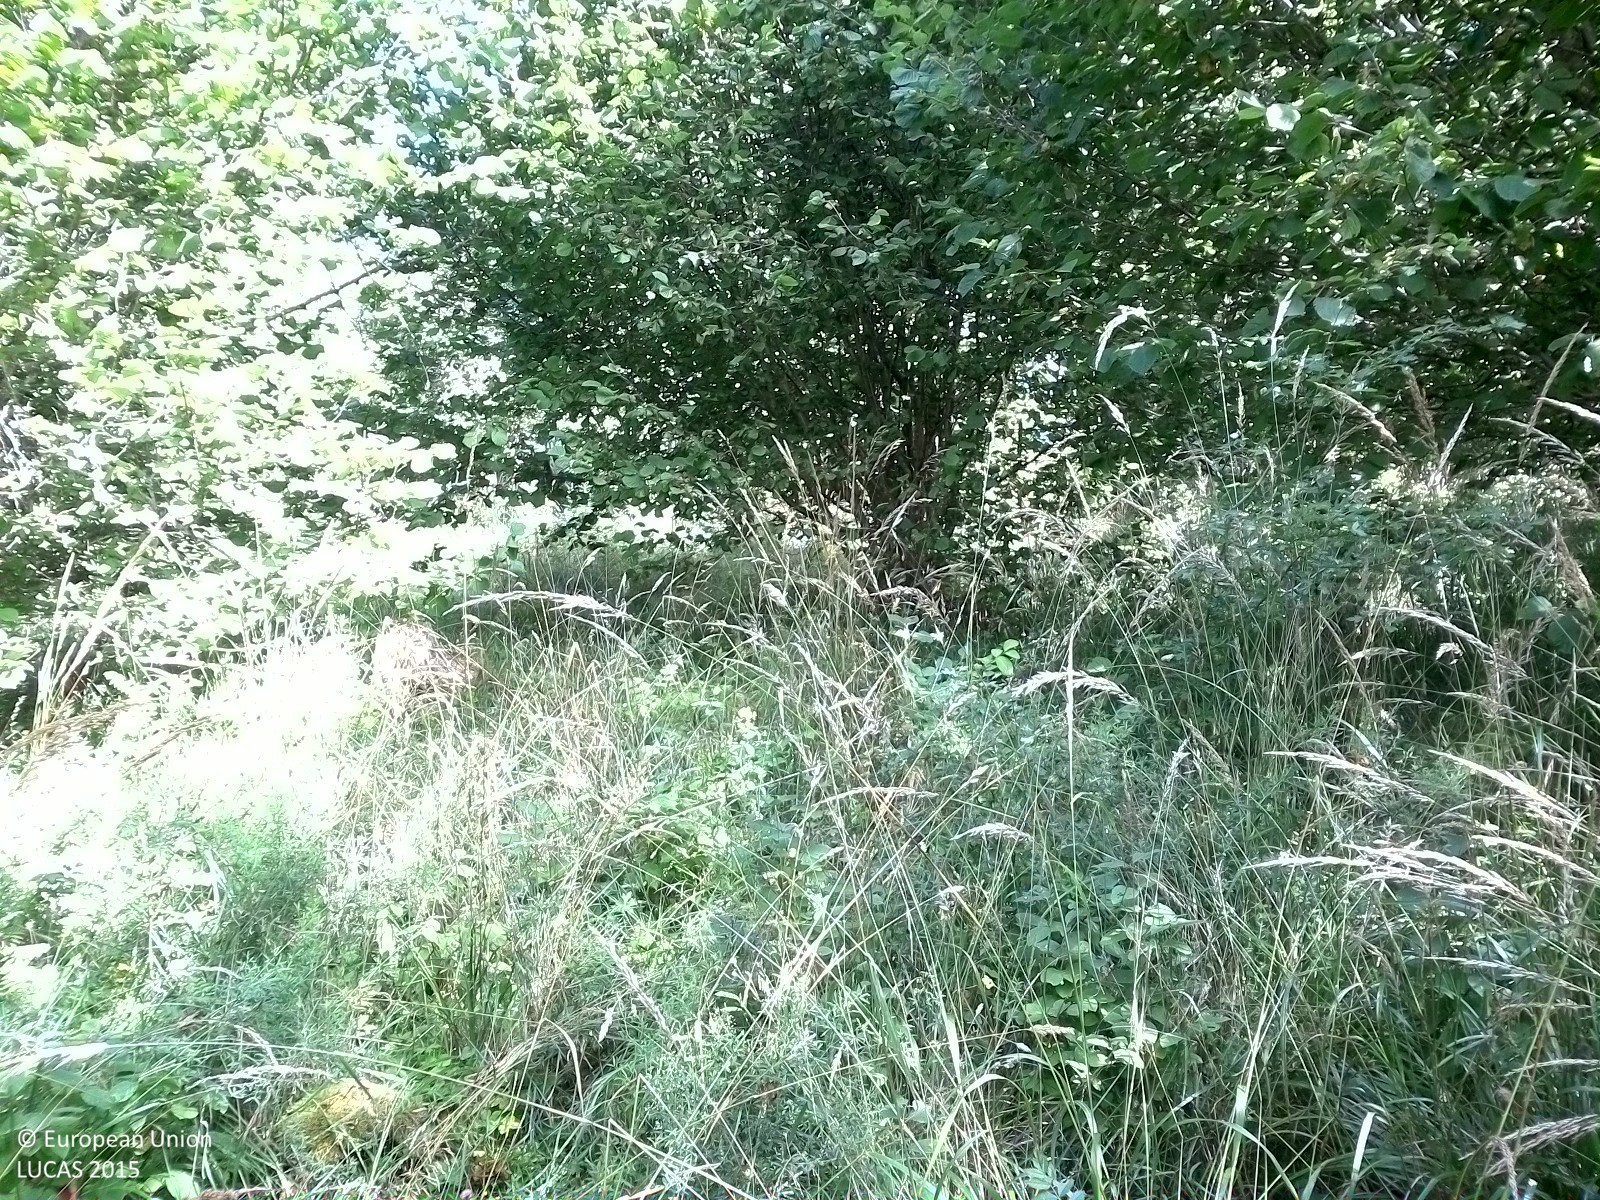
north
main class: Woodland
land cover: Broadleaved woodland
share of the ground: 25 - 50 %
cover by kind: broadleaved forest trees 45 %, herbaceous plants 40 %, shrubs 15 %
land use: Semi-natural and natural areas not in use
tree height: < 5 m
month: August
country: SE
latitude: 59.1672
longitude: 14.6273
